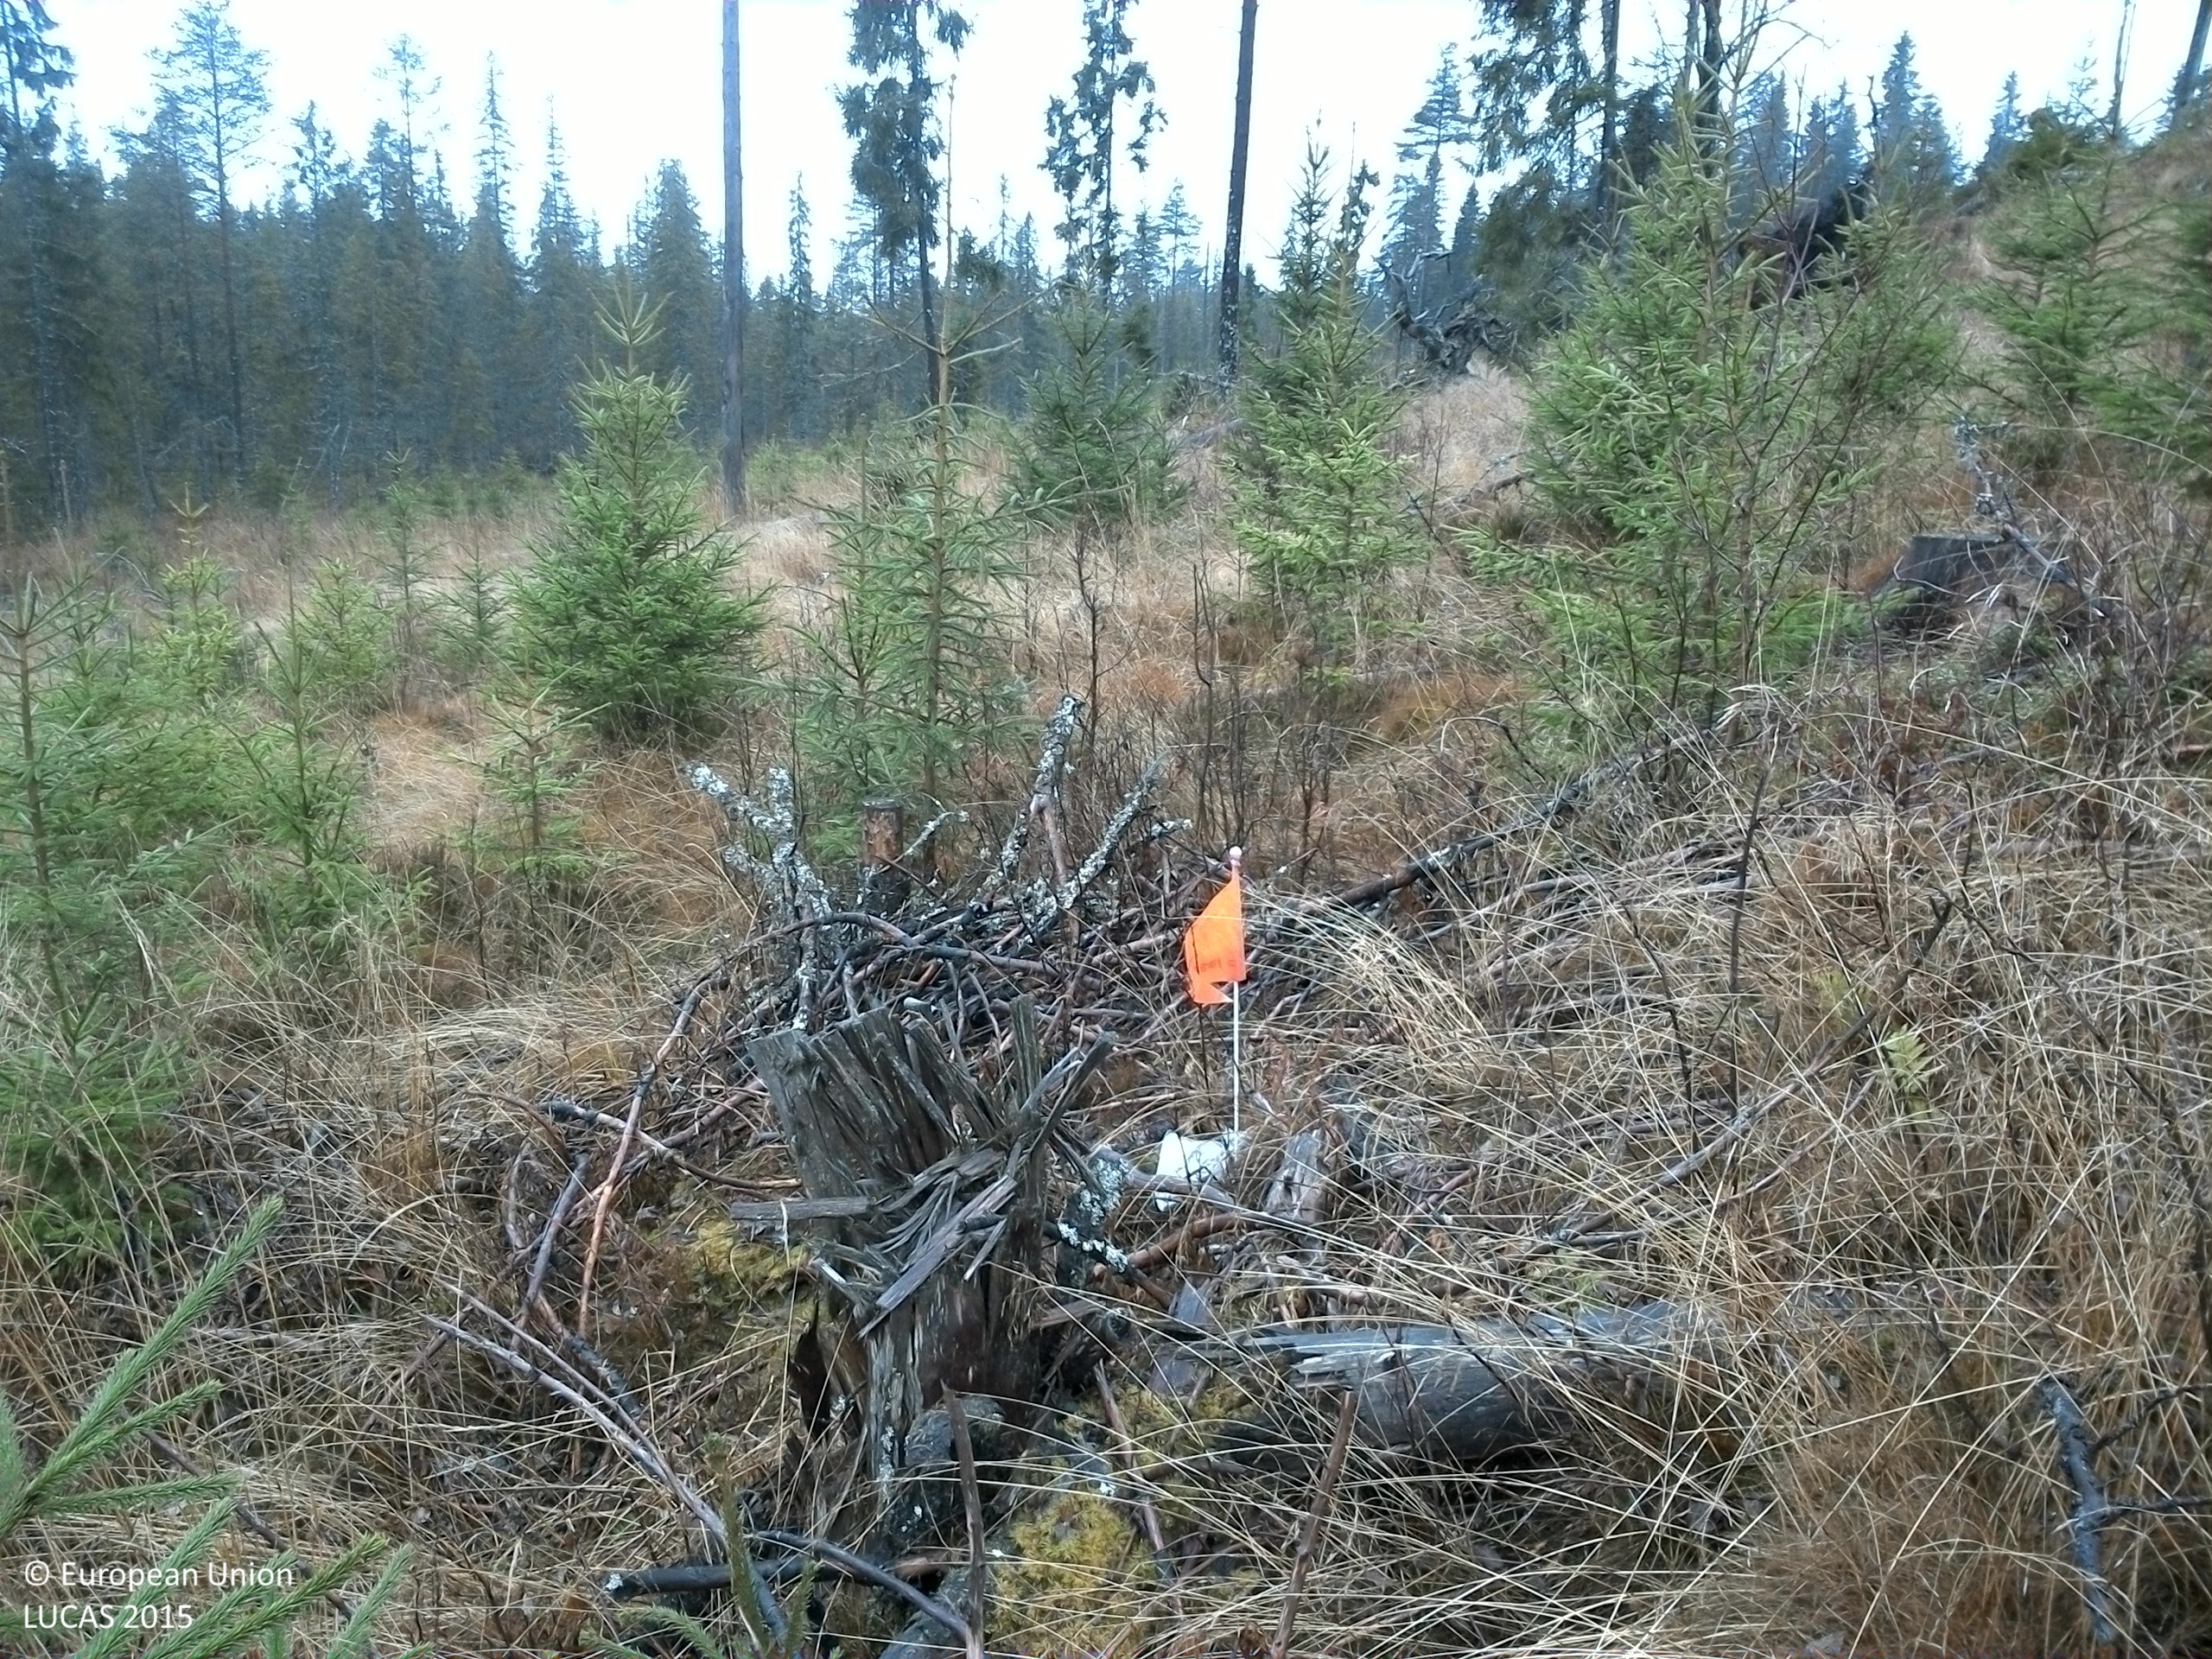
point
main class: Woodland
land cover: Spruce dominated mixed woodland
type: boreal forest
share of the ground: 25 - 50 %
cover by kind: herbaceous plants 40 %, coniferous forest trees 25 %, shrubs 20 %, broadleaved forest trees 10 %, lichens and mosses 5 %
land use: Forestry
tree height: < 5 m
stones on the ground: 10 - 25 %
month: November
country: SE
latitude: 60.0694
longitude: 14.6071
